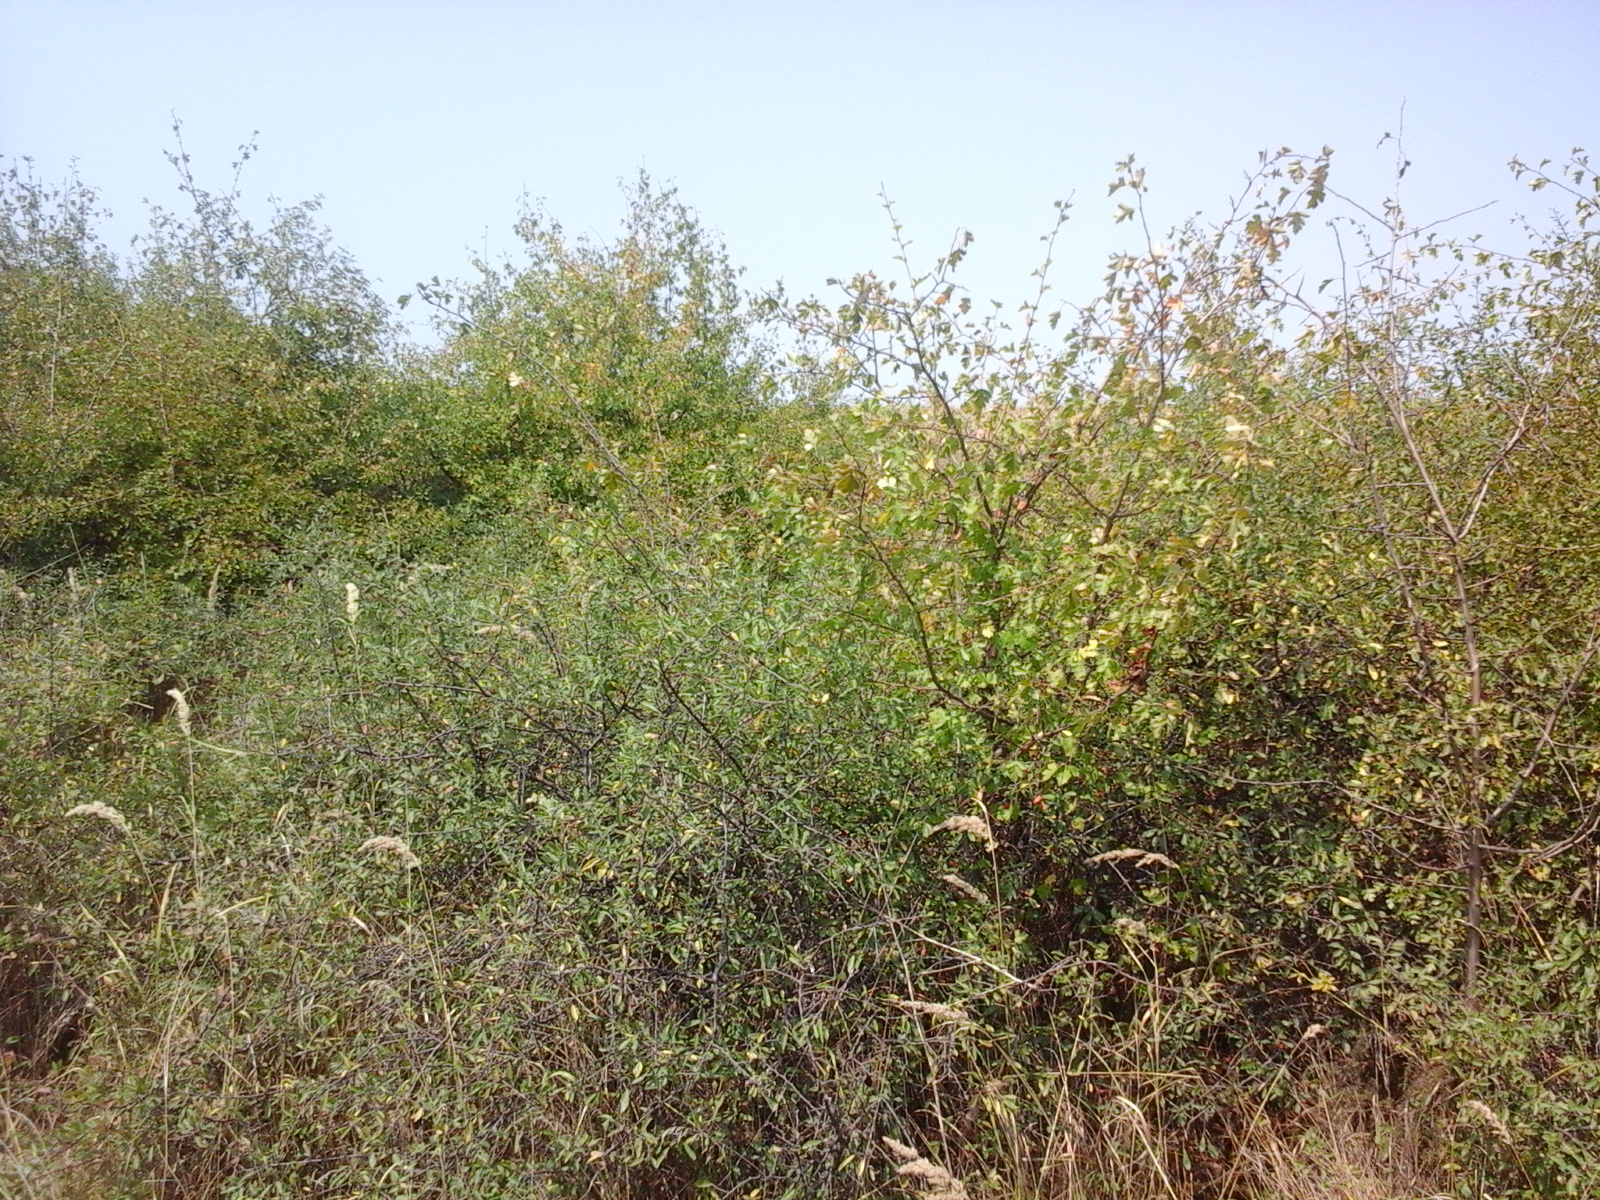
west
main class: Shrubland
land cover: Shrubland with sparse tree cover
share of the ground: > 75 %
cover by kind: shrubs 95 %, broadleaved forest trees 5 %
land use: Semi-natural and natural areas not in use
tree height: < 5 m
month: August
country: RO
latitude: 44.5042
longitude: 23.7805
